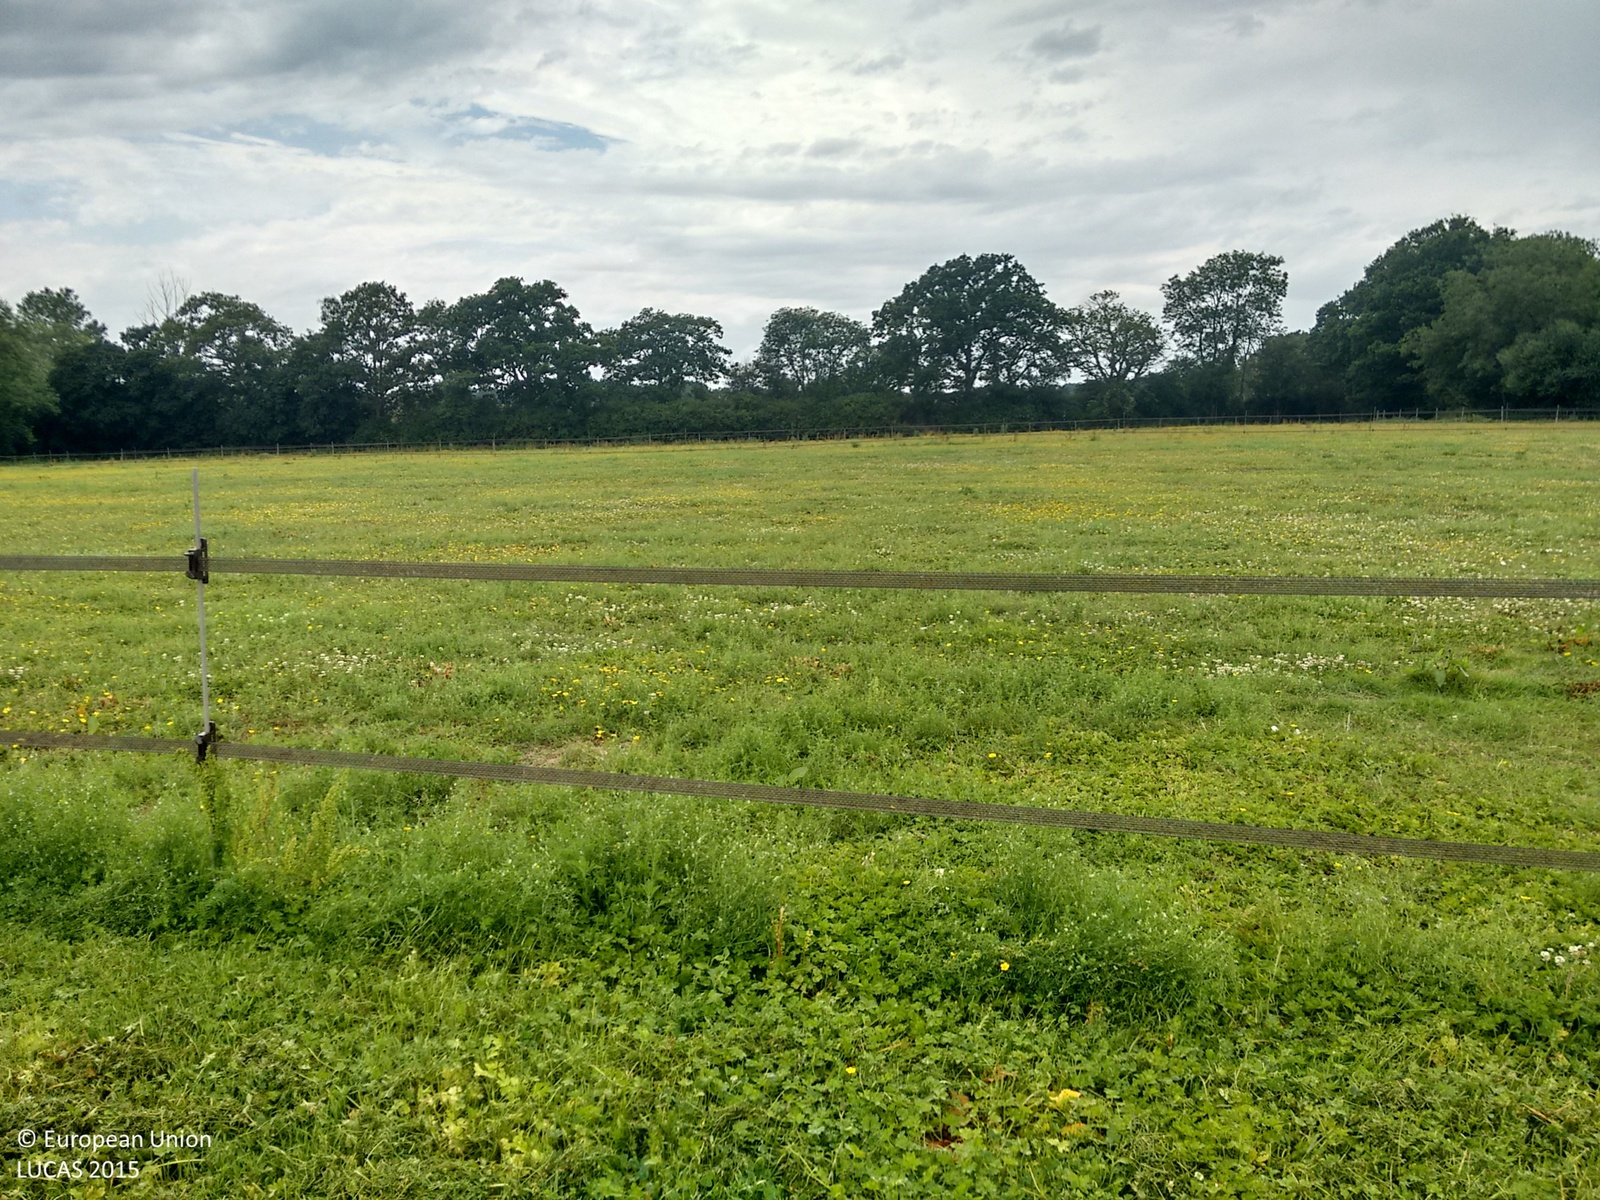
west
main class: Grassland
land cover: Grassland without tree/shrub cover
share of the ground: > 75 %
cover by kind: herbaceous plants 100 %
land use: Agriculture (excluding fallow land and kitchen gardens)
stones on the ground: < 10 %
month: July
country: GB
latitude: 50.9925
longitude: -0.2221
